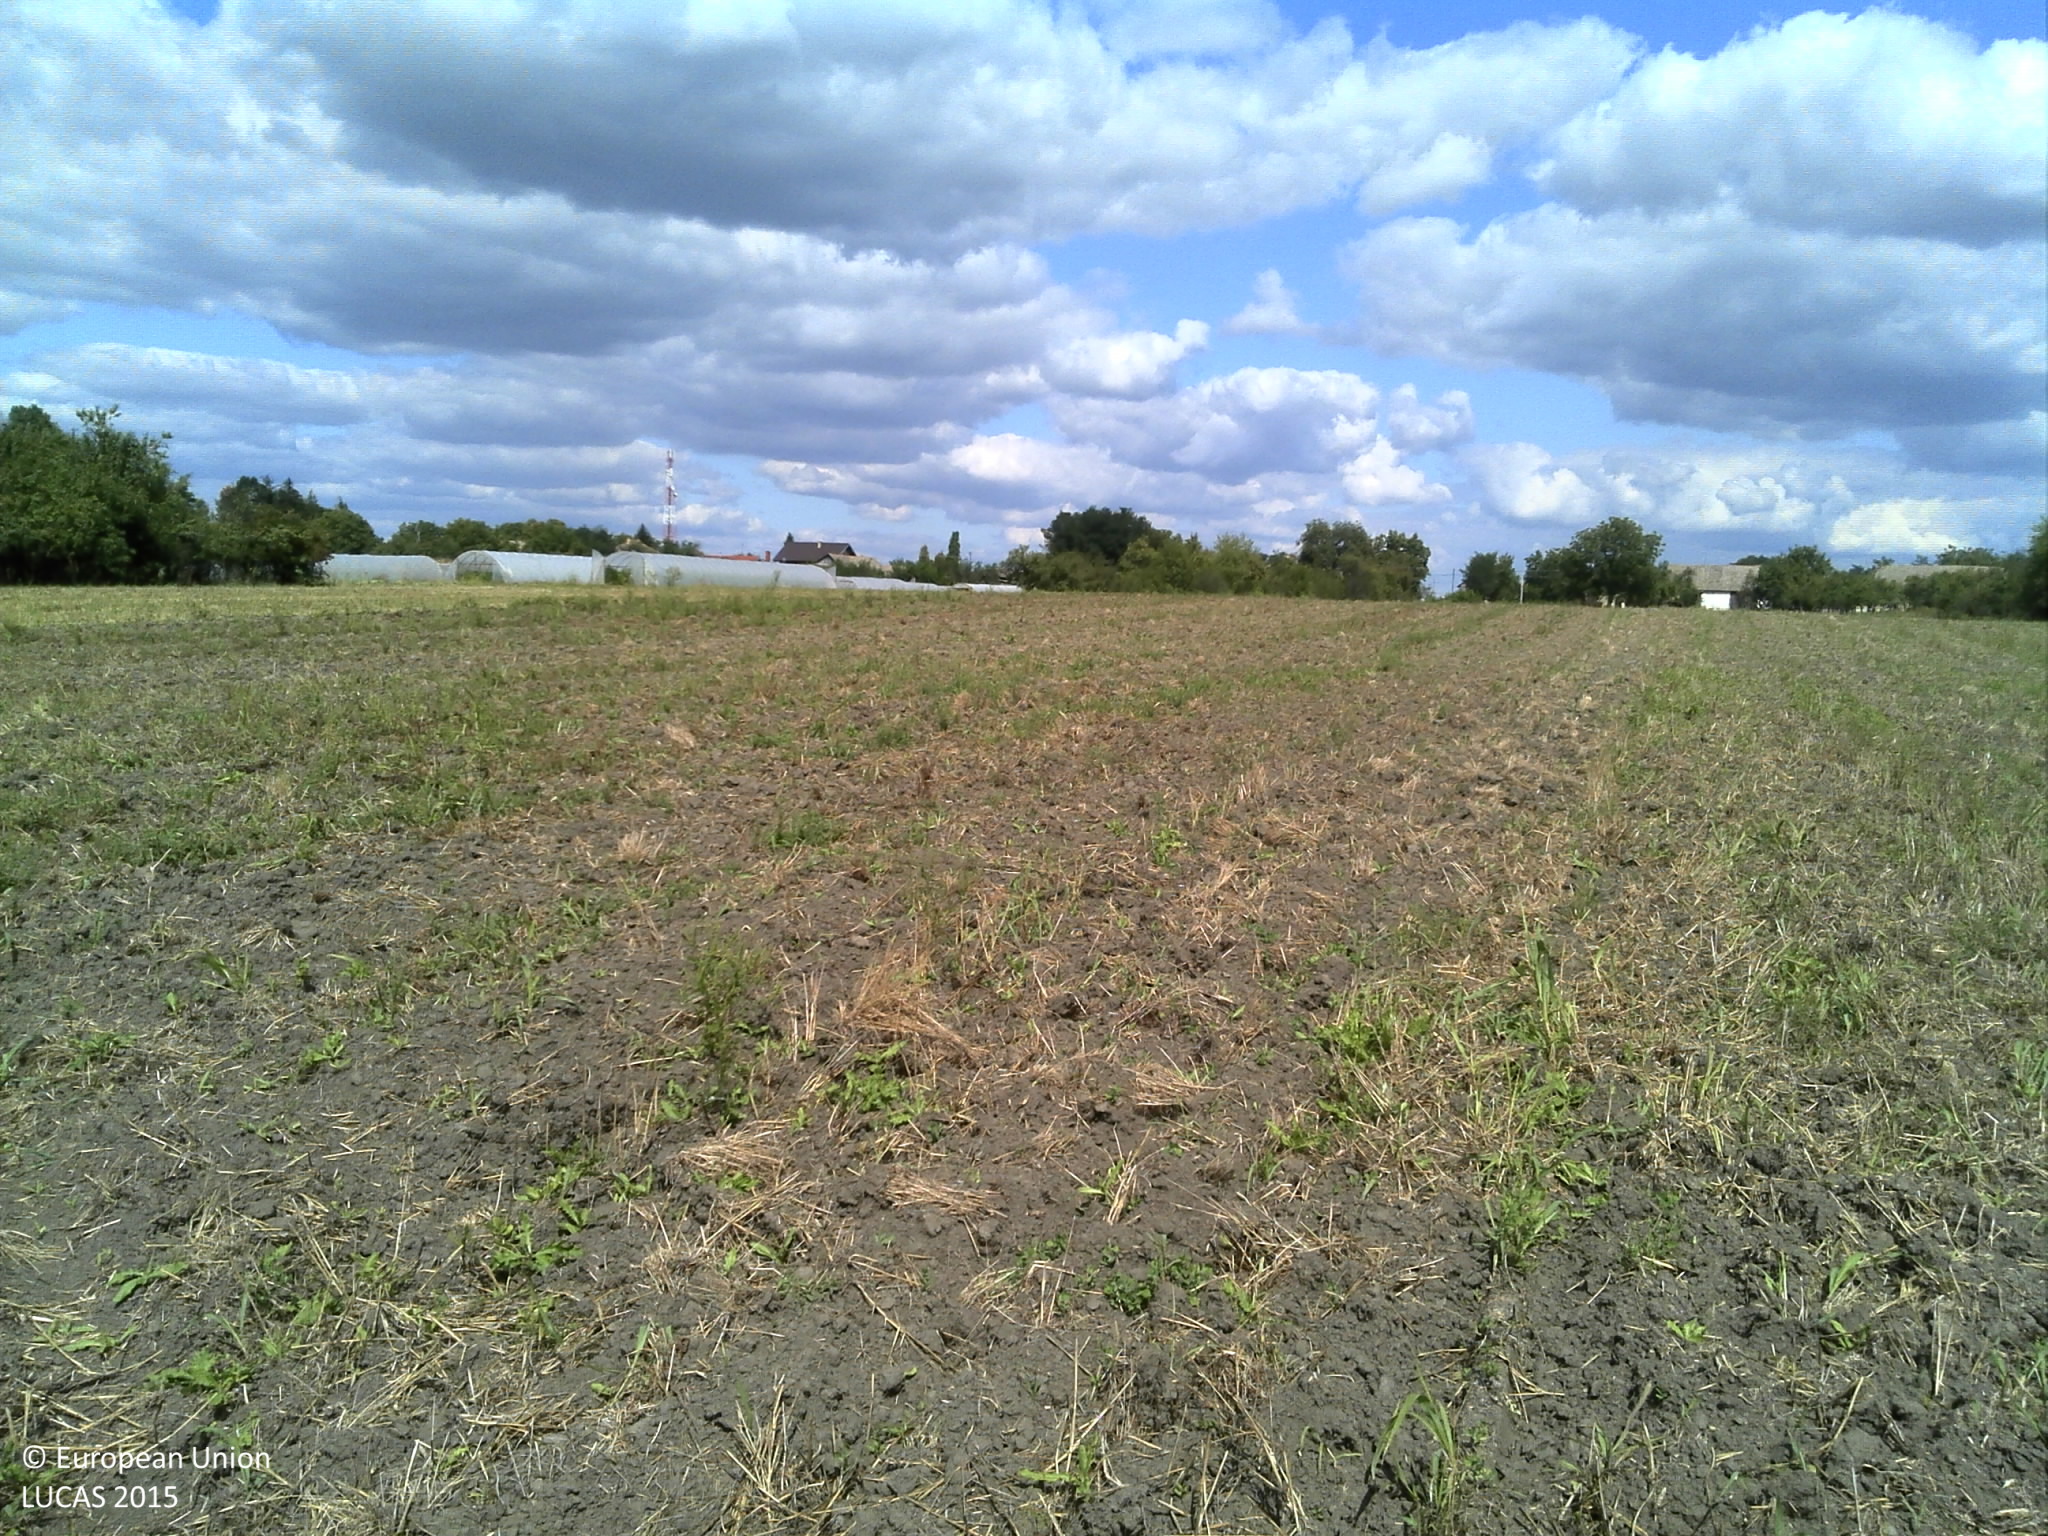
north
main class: Cropland
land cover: Barley
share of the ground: > 75 %
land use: Agriculture (excluding fallow land and kitchen gardens)
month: September
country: HR
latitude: 45.6965
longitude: 18.5993
